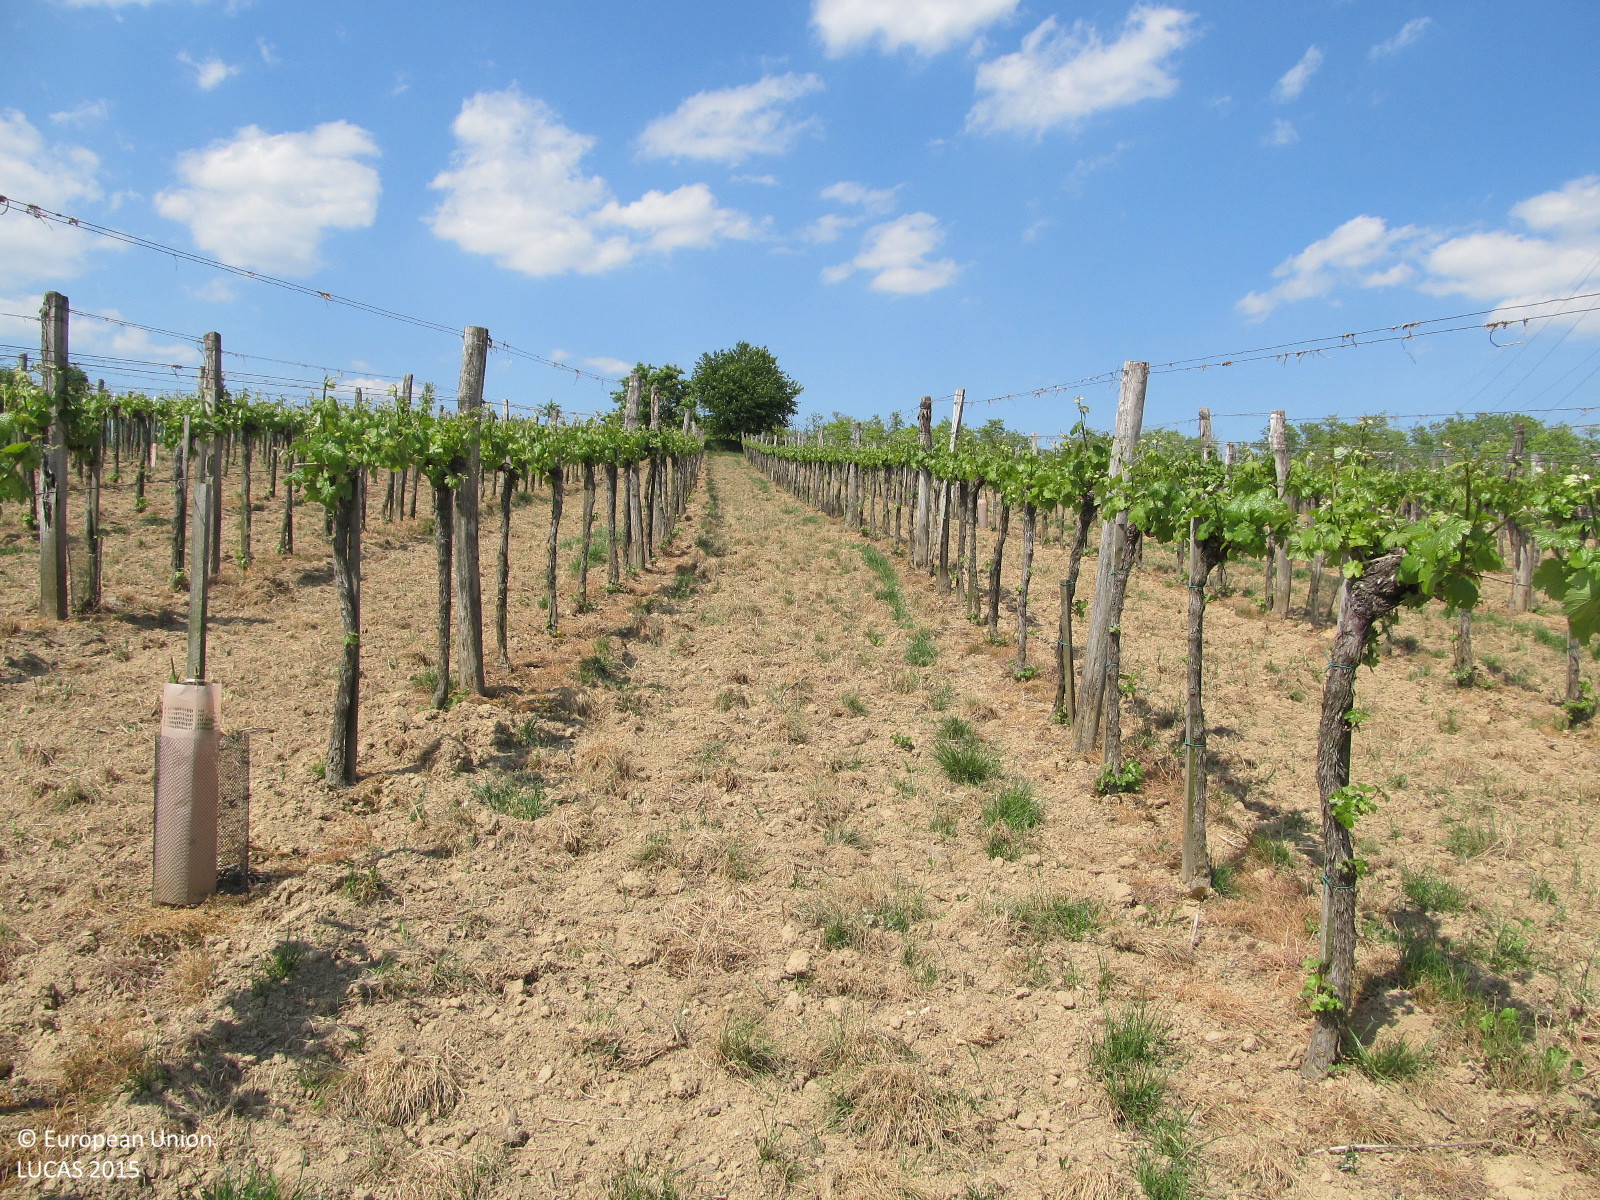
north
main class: Cropland
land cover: Vineyards
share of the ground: 25 - 50 %
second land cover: Spontaneously vegetated surfaces
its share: 50 - 75 %
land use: Agriculture (excluding fallow land and kitchen gardens)
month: May
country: AT
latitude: 48.5363
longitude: 15.8681
